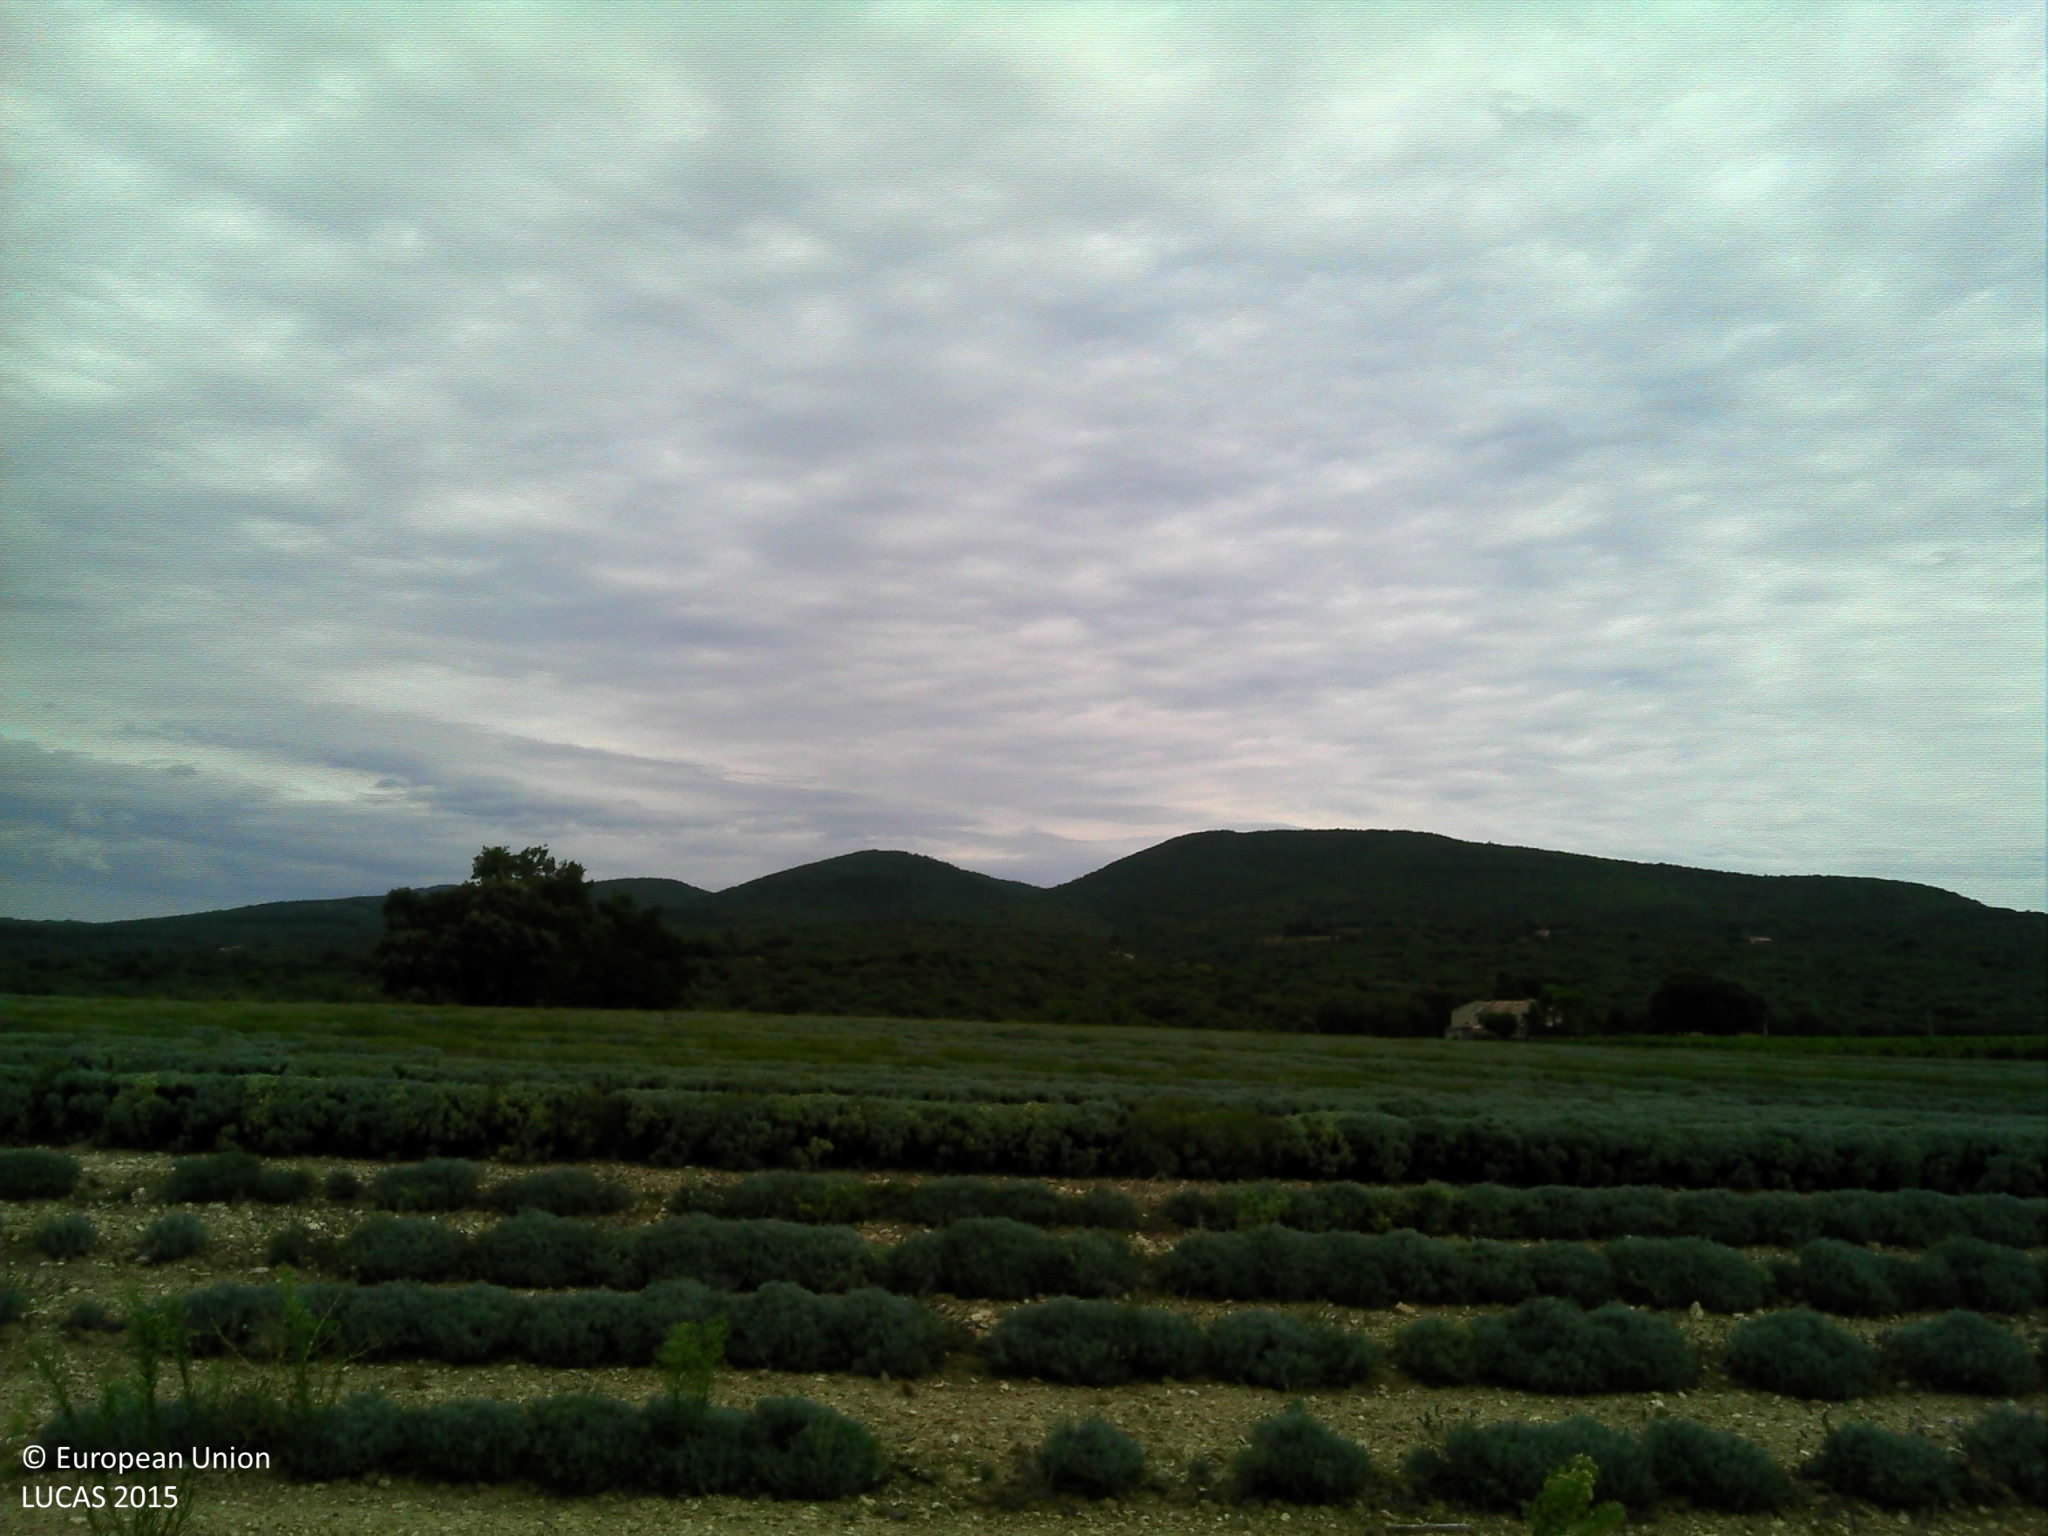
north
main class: Cropland
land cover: Permanent industrial crops
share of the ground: 25 - 50 %
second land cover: Other bare soil
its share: > 75 %
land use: Agriculture (excluding fallow land and kitchen gardens)
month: September
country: FR
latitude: 44.4465
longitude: 4.9935
